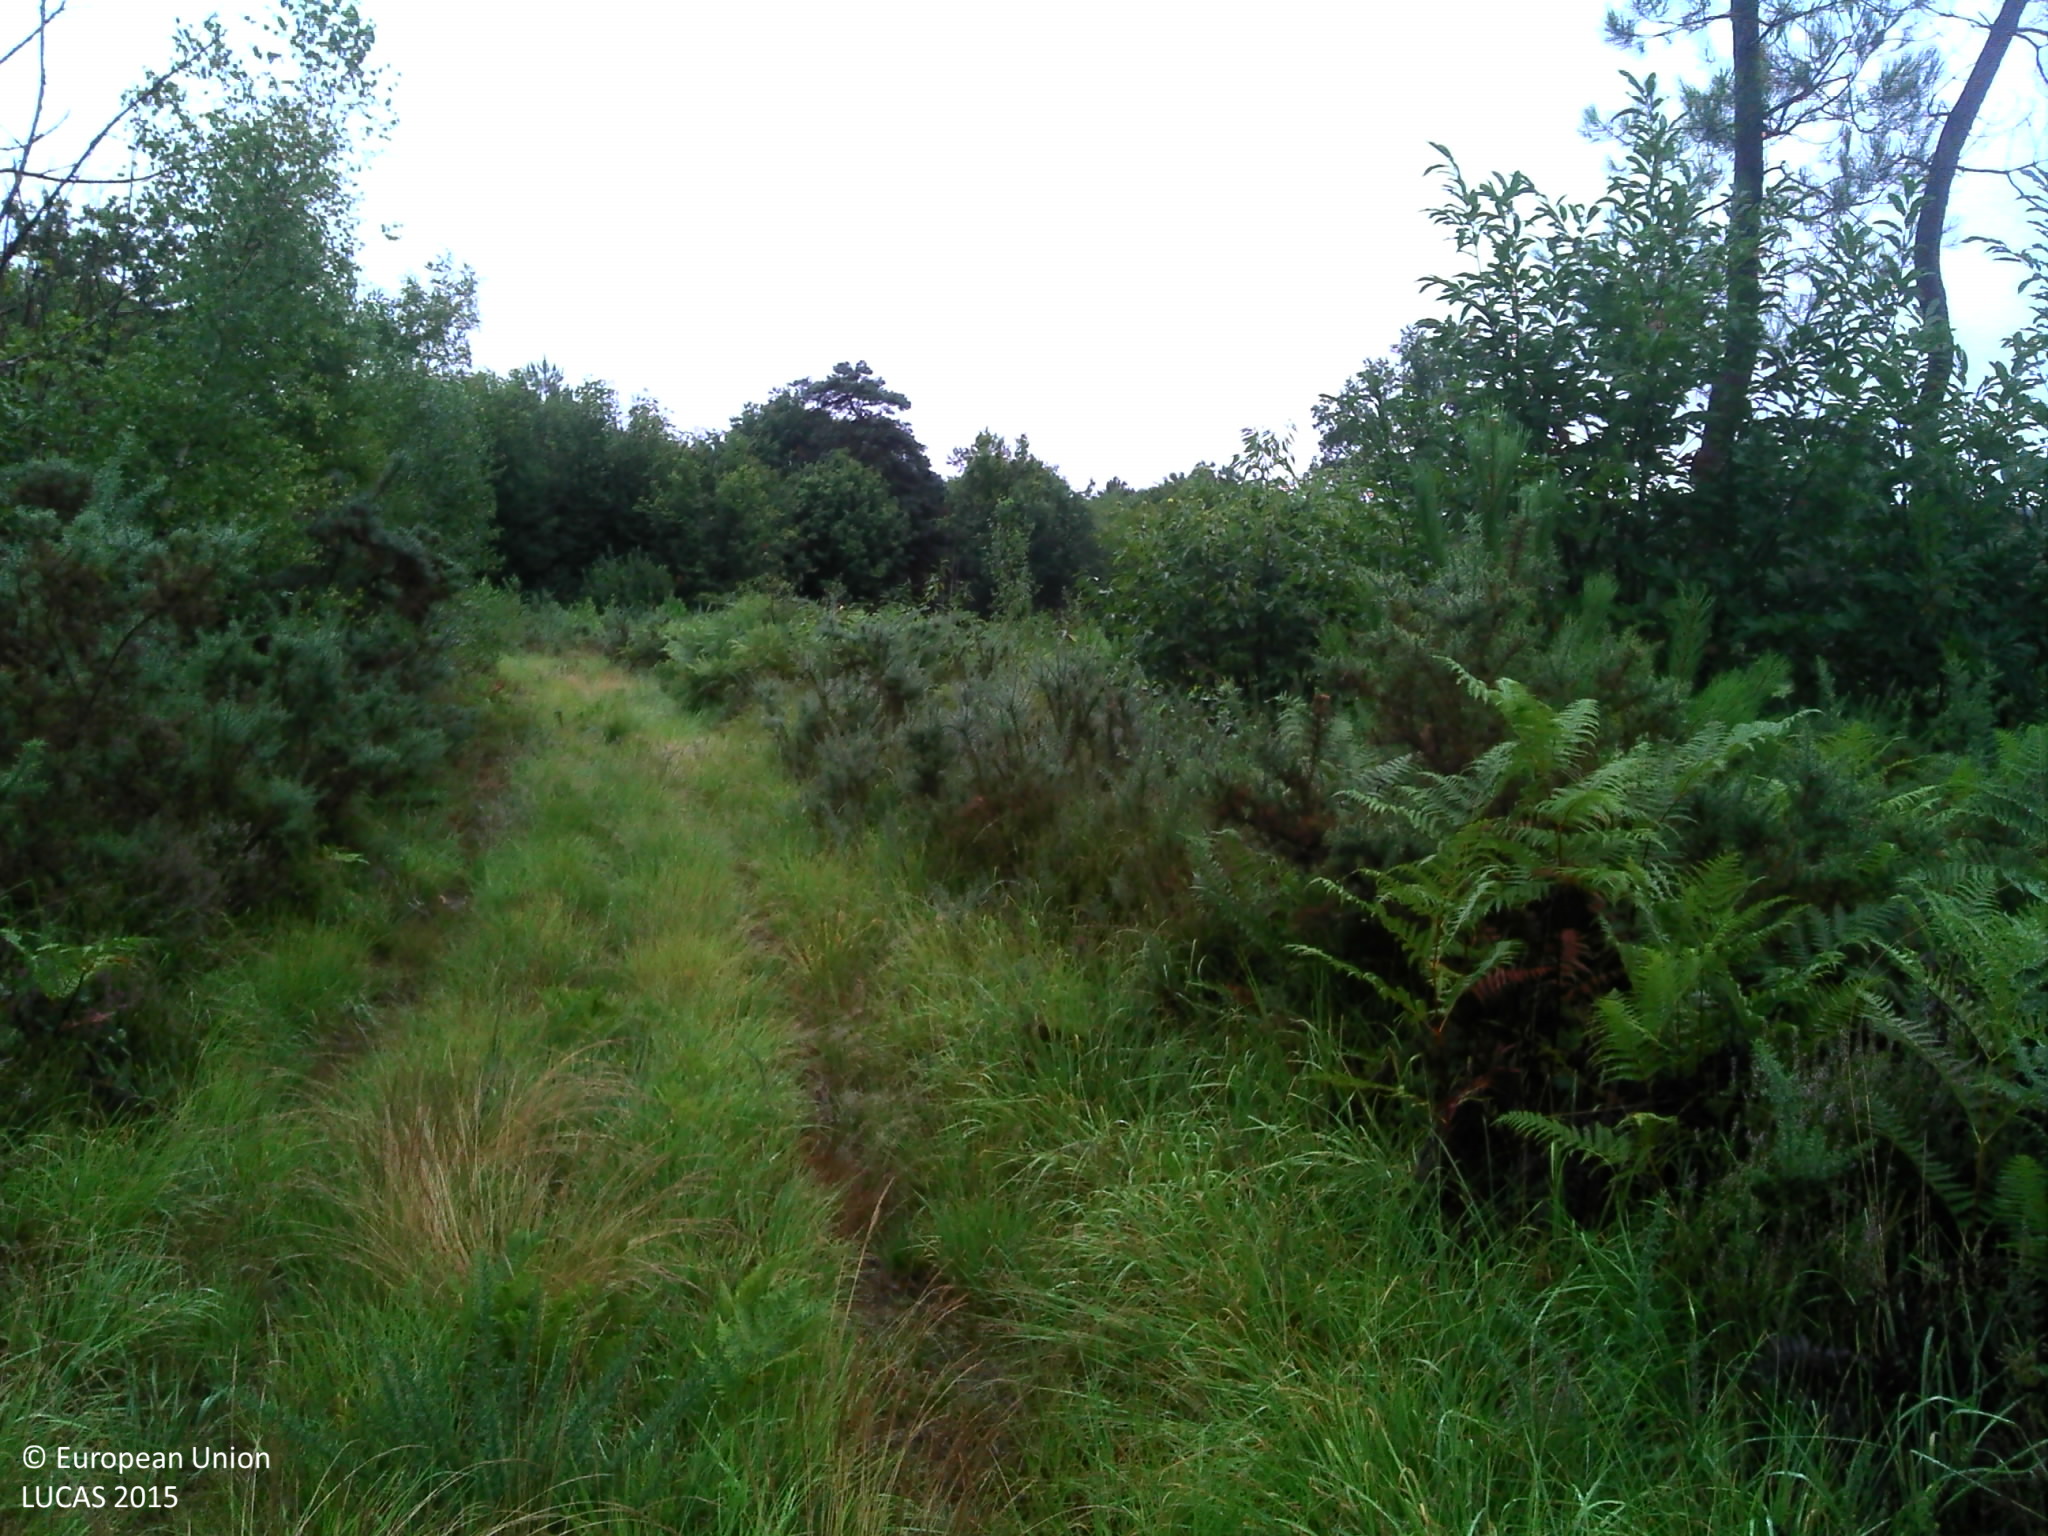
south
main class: Woodland
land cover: Broadleaved woodland
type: thermophilous deciduous forest
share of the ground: > 75 %
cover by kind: broadleaved forest trees 65 %, coniferous forest trees 10 %, herbaceous plants 10 %, consolidated bare surface 10 %, shrubs 5 %
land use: Forestry
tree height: > 5 m
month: August
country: FR
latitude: 45.4729
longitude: 0.6891
